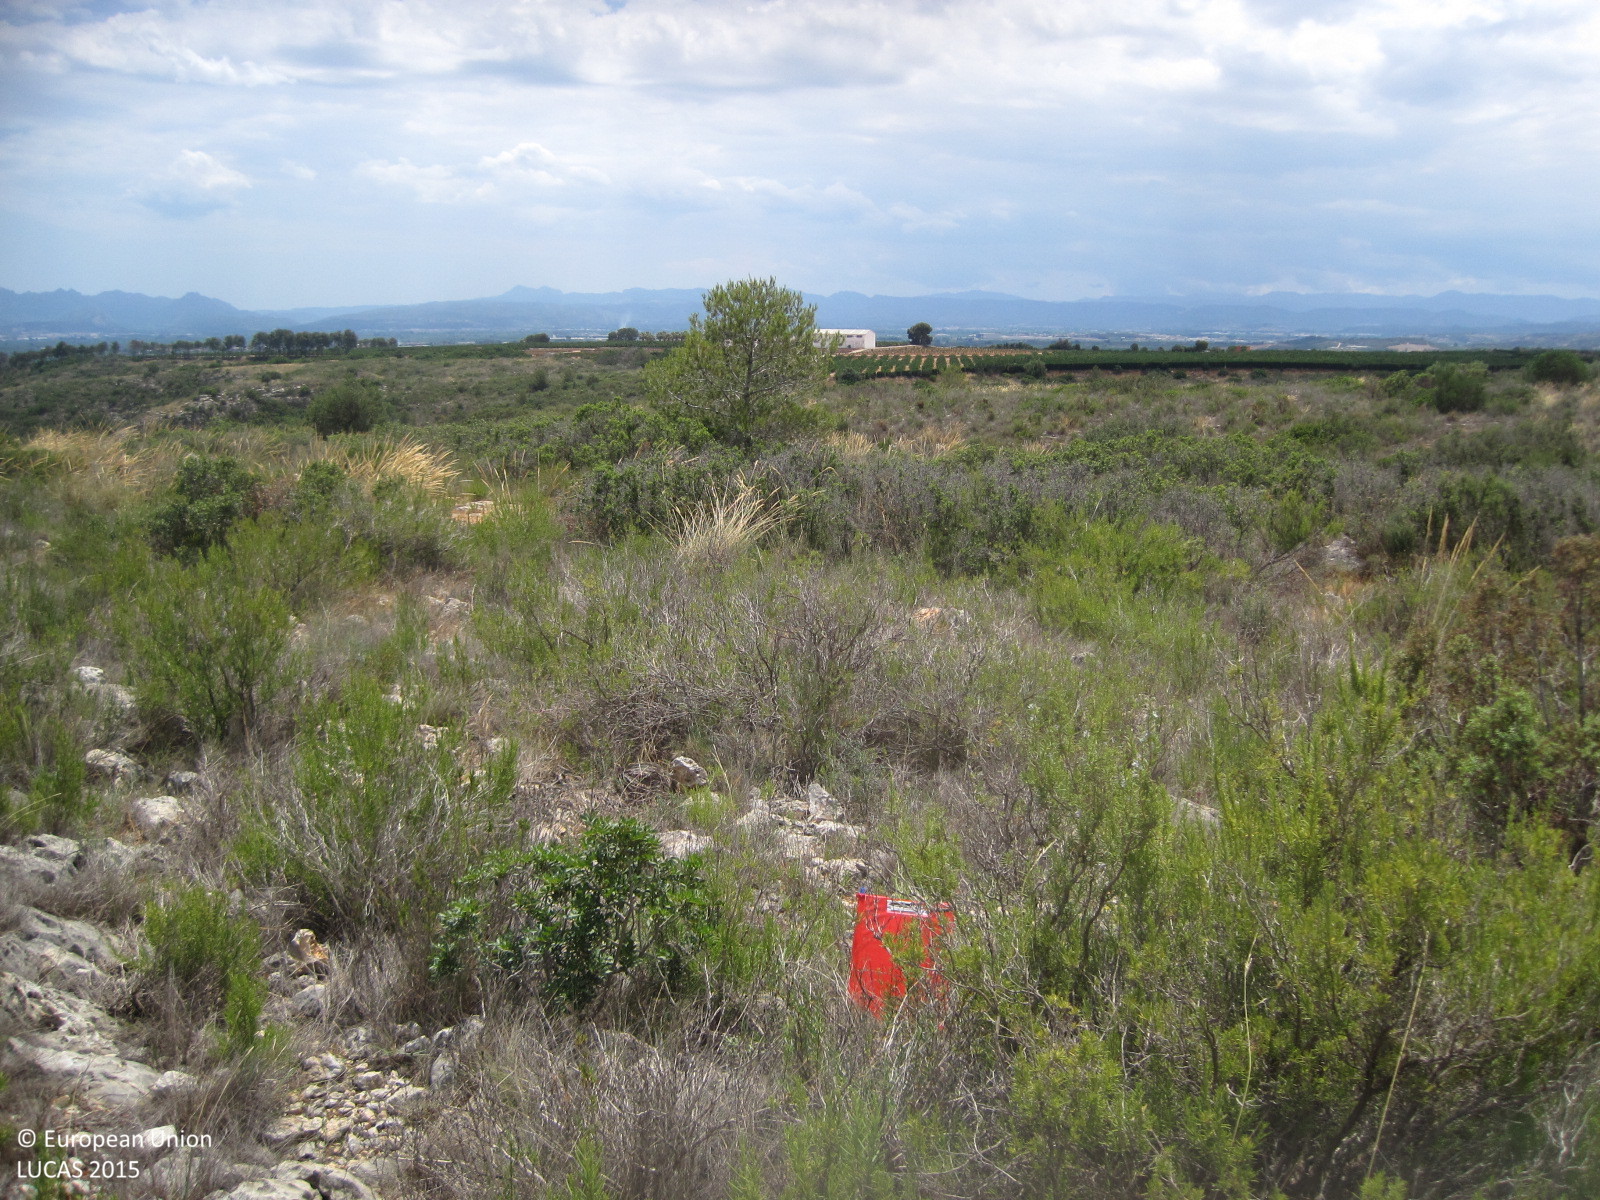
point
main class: Shrubland
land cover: Shrubland without tree cover
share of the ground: 25 - 50 %
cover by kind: shrubs 40 %, herbaceous plants 30 %, consolidated bare surface 30 %
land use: Semi-natural and natural areas not in use
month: June
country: ES
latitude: 39.2000
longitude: -0.5904
